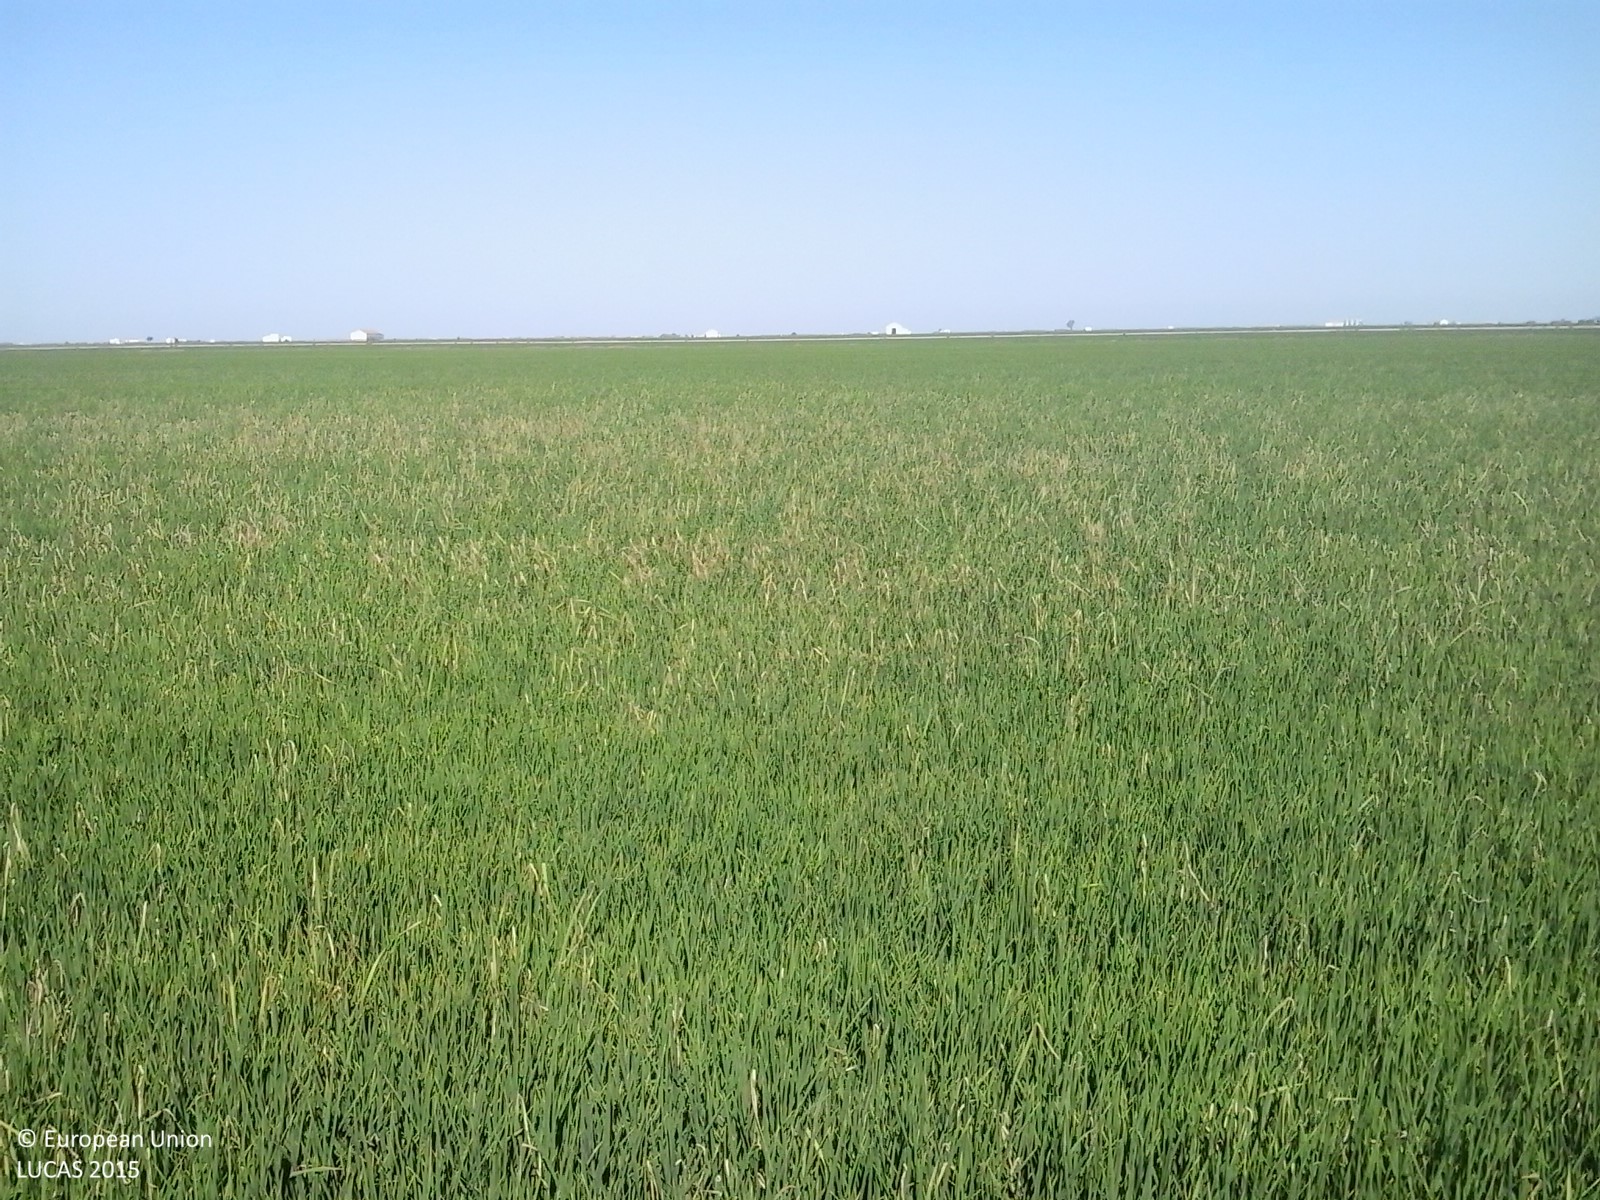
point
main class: Cropland
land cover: Rice
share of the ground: > 75 %
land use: Agriculture (excluding fallow land and kitchen gardens)
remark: Temporary flooded
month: July
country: ES
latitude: 37.0684
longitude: -6.0912
